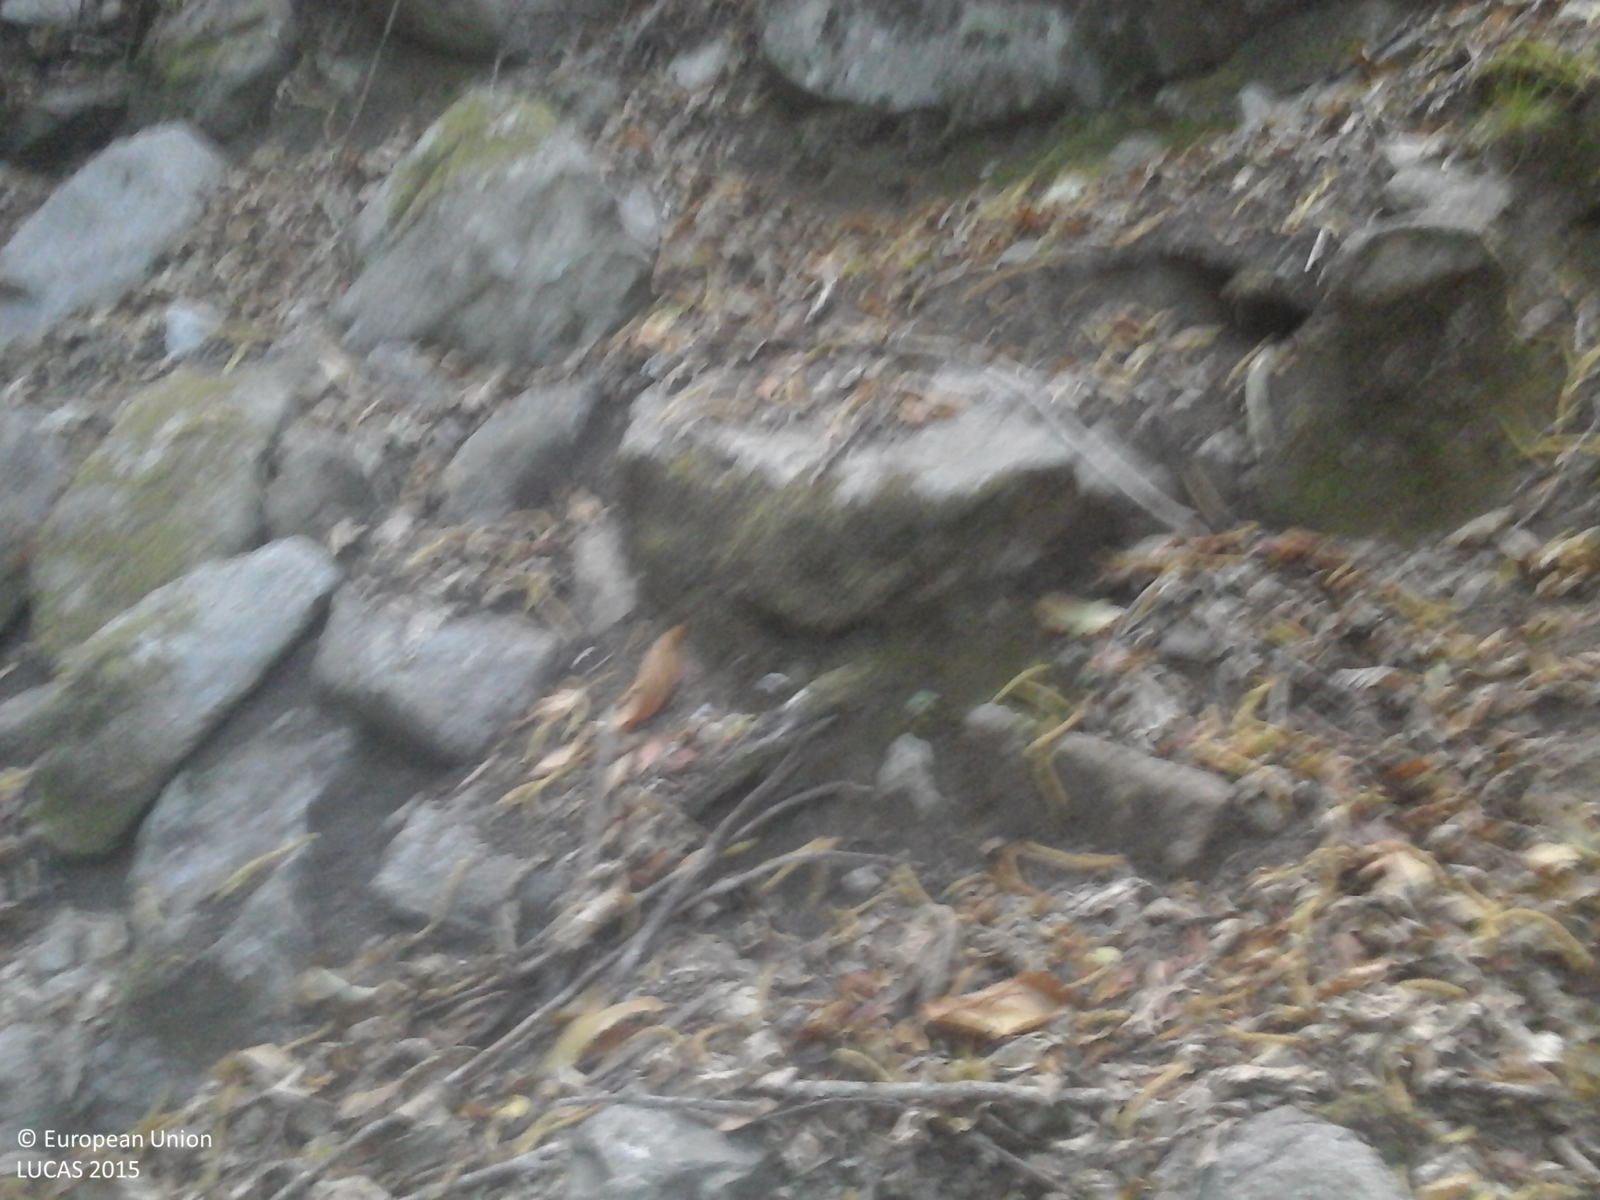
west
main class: Woodland
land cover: Broadleaved woodland
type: thermophilous deciduous forest
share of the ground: > 75 %
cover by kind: broadleaved forest trees 100 %
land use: Forestry
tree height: > 5 m
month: July
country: IT
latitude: 42.7803
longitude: 10.1827
